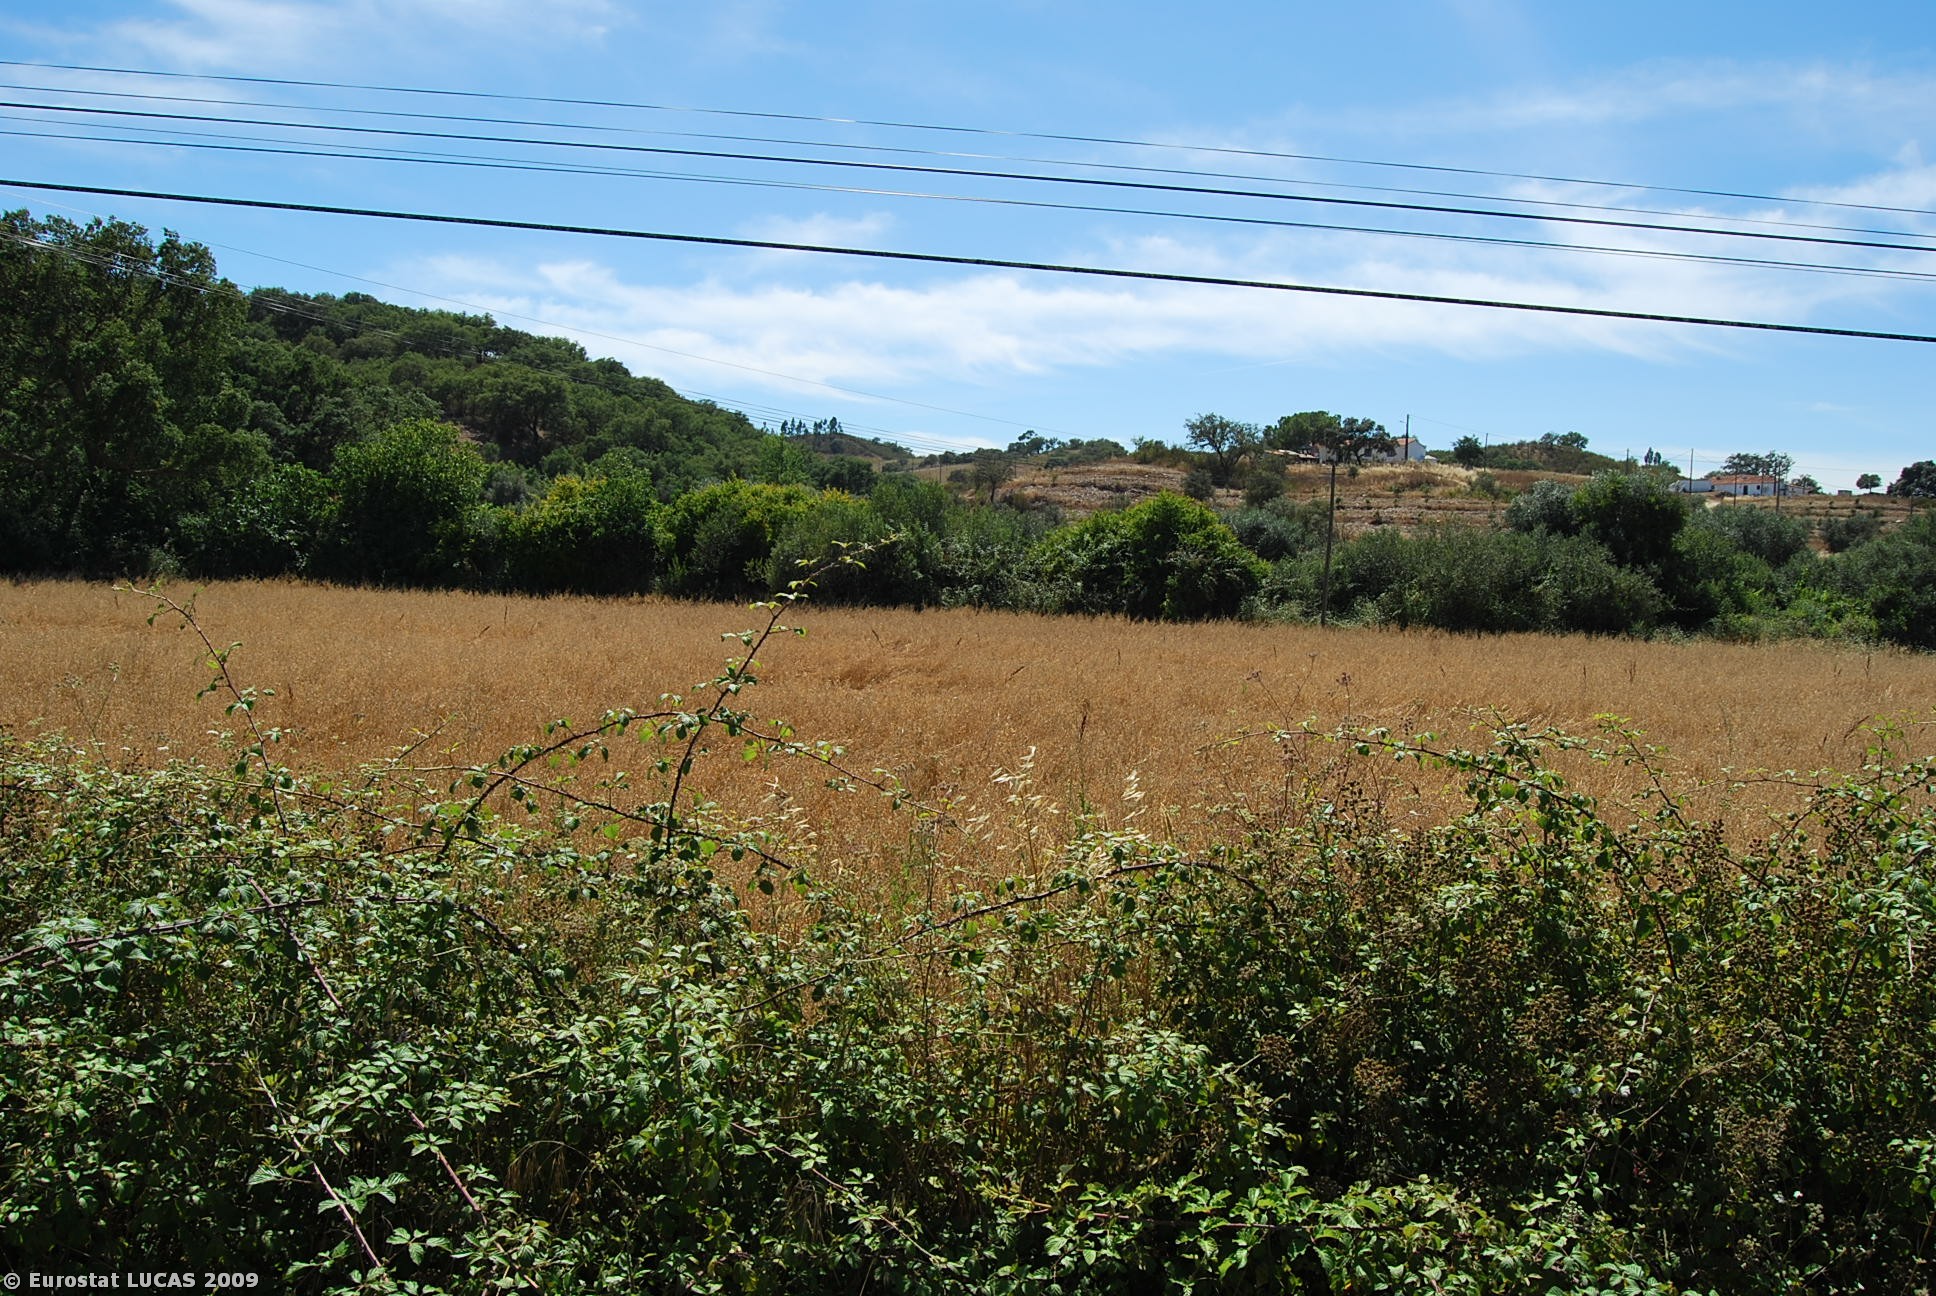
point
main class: Grassland
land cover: Spontaneously vegetated surfaces
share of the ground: > 75 %
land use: Fallow land
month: July
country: PT
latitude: 37.6745
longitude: -8.4129
